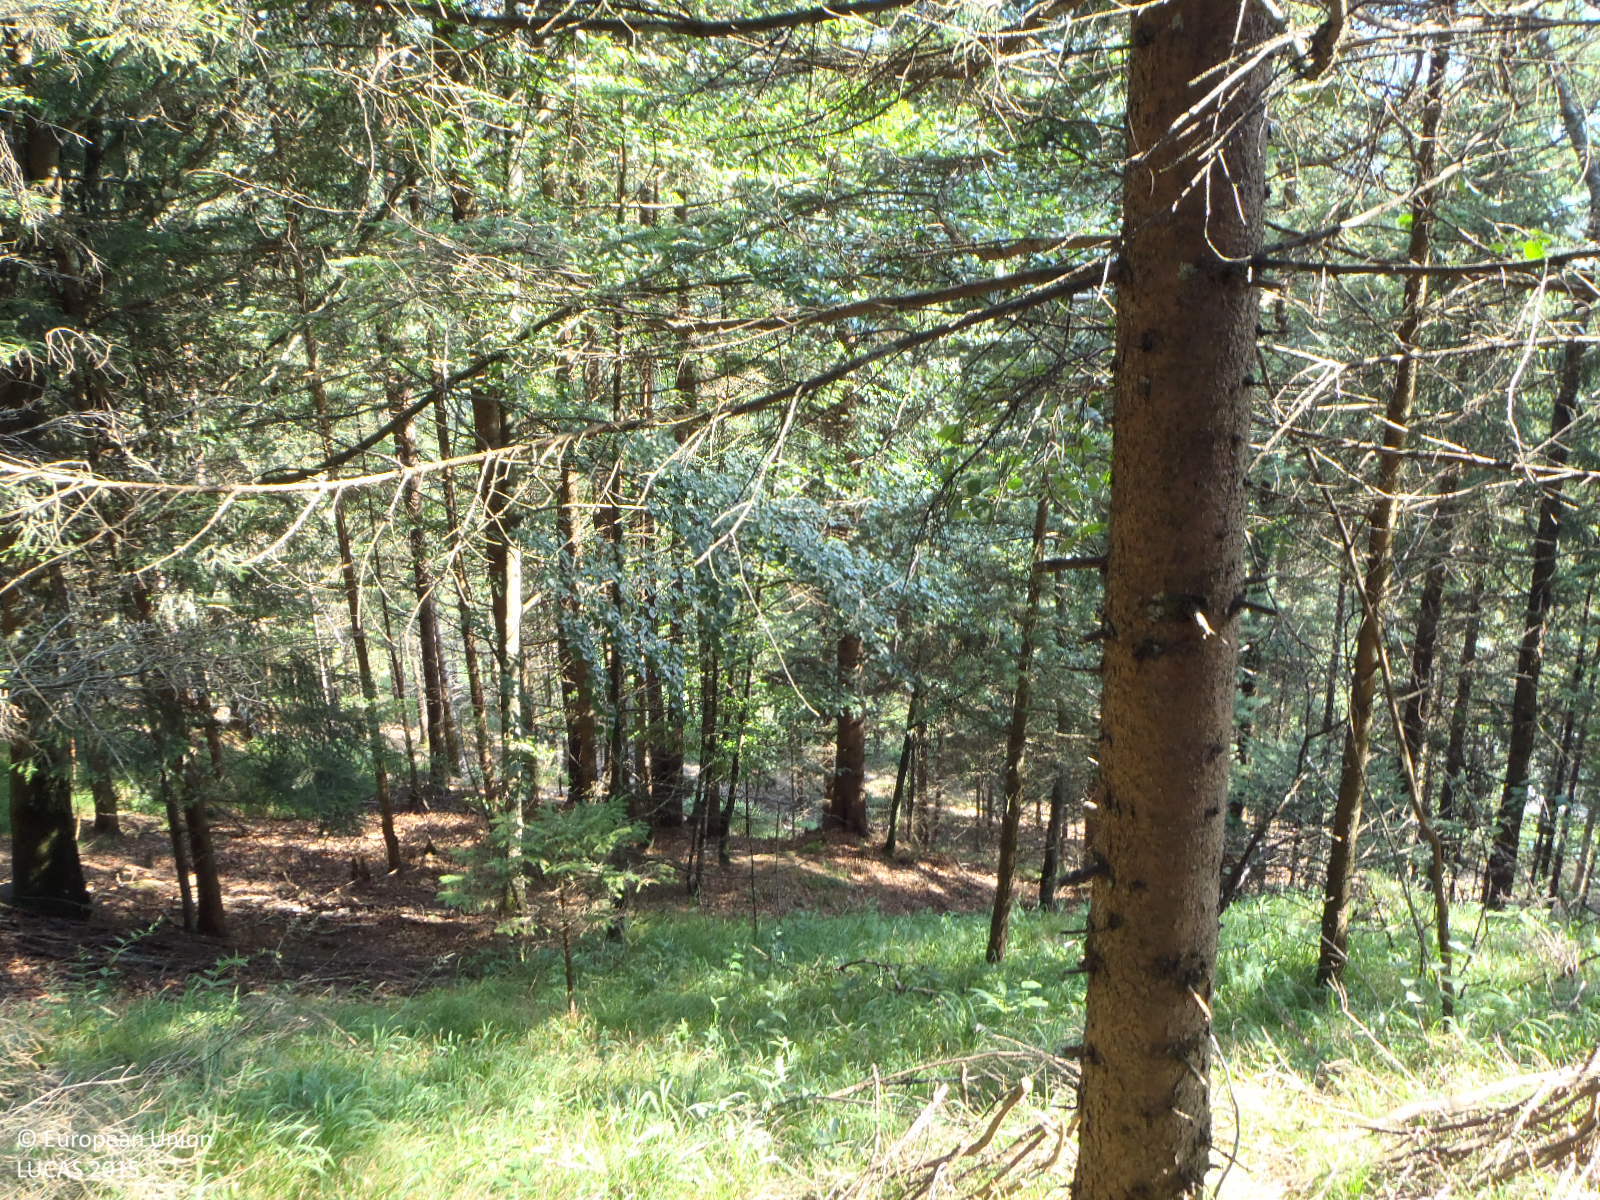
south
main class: Woodland
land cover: Spruce dominated mixed woodland
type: alpine coniferous forest
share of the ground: > 75 %
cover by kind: coniferous forest trees 70 %, broadleaved forest trees 25 %, herbaceous plants 5 %
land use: Forestry
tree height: > 5 m
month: July
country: AT
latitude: 47.4331
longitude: 11.8945
